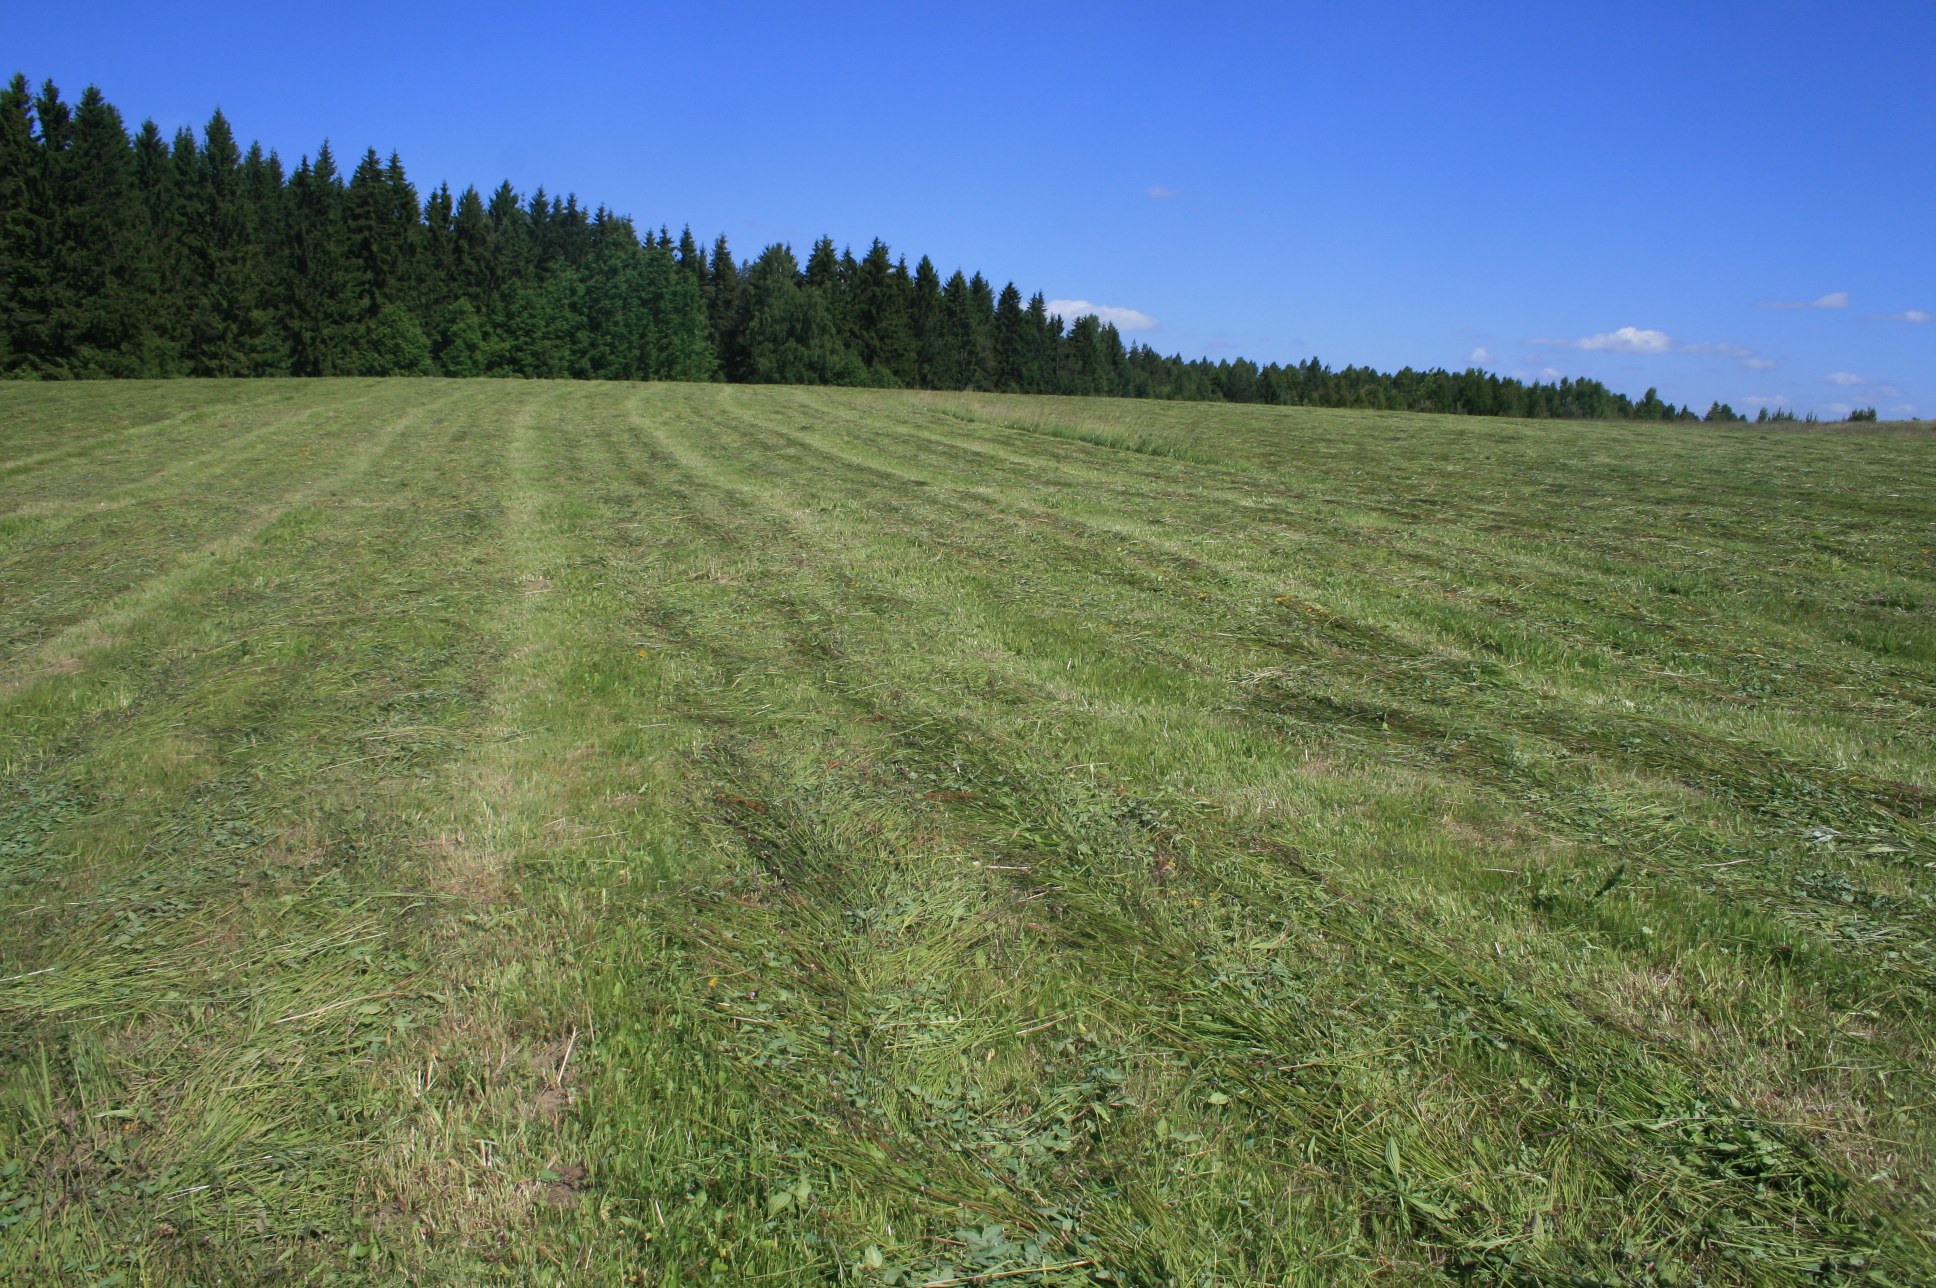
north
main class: Grassland
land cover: Grassland without tree/shrub cover
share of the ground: > 75 %
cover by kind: herbaceous plants 100 %
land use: Agriculture (excluding fallow land and kitchen gardens)
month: June
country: LT
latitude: 55.8506
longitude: 22.2755
